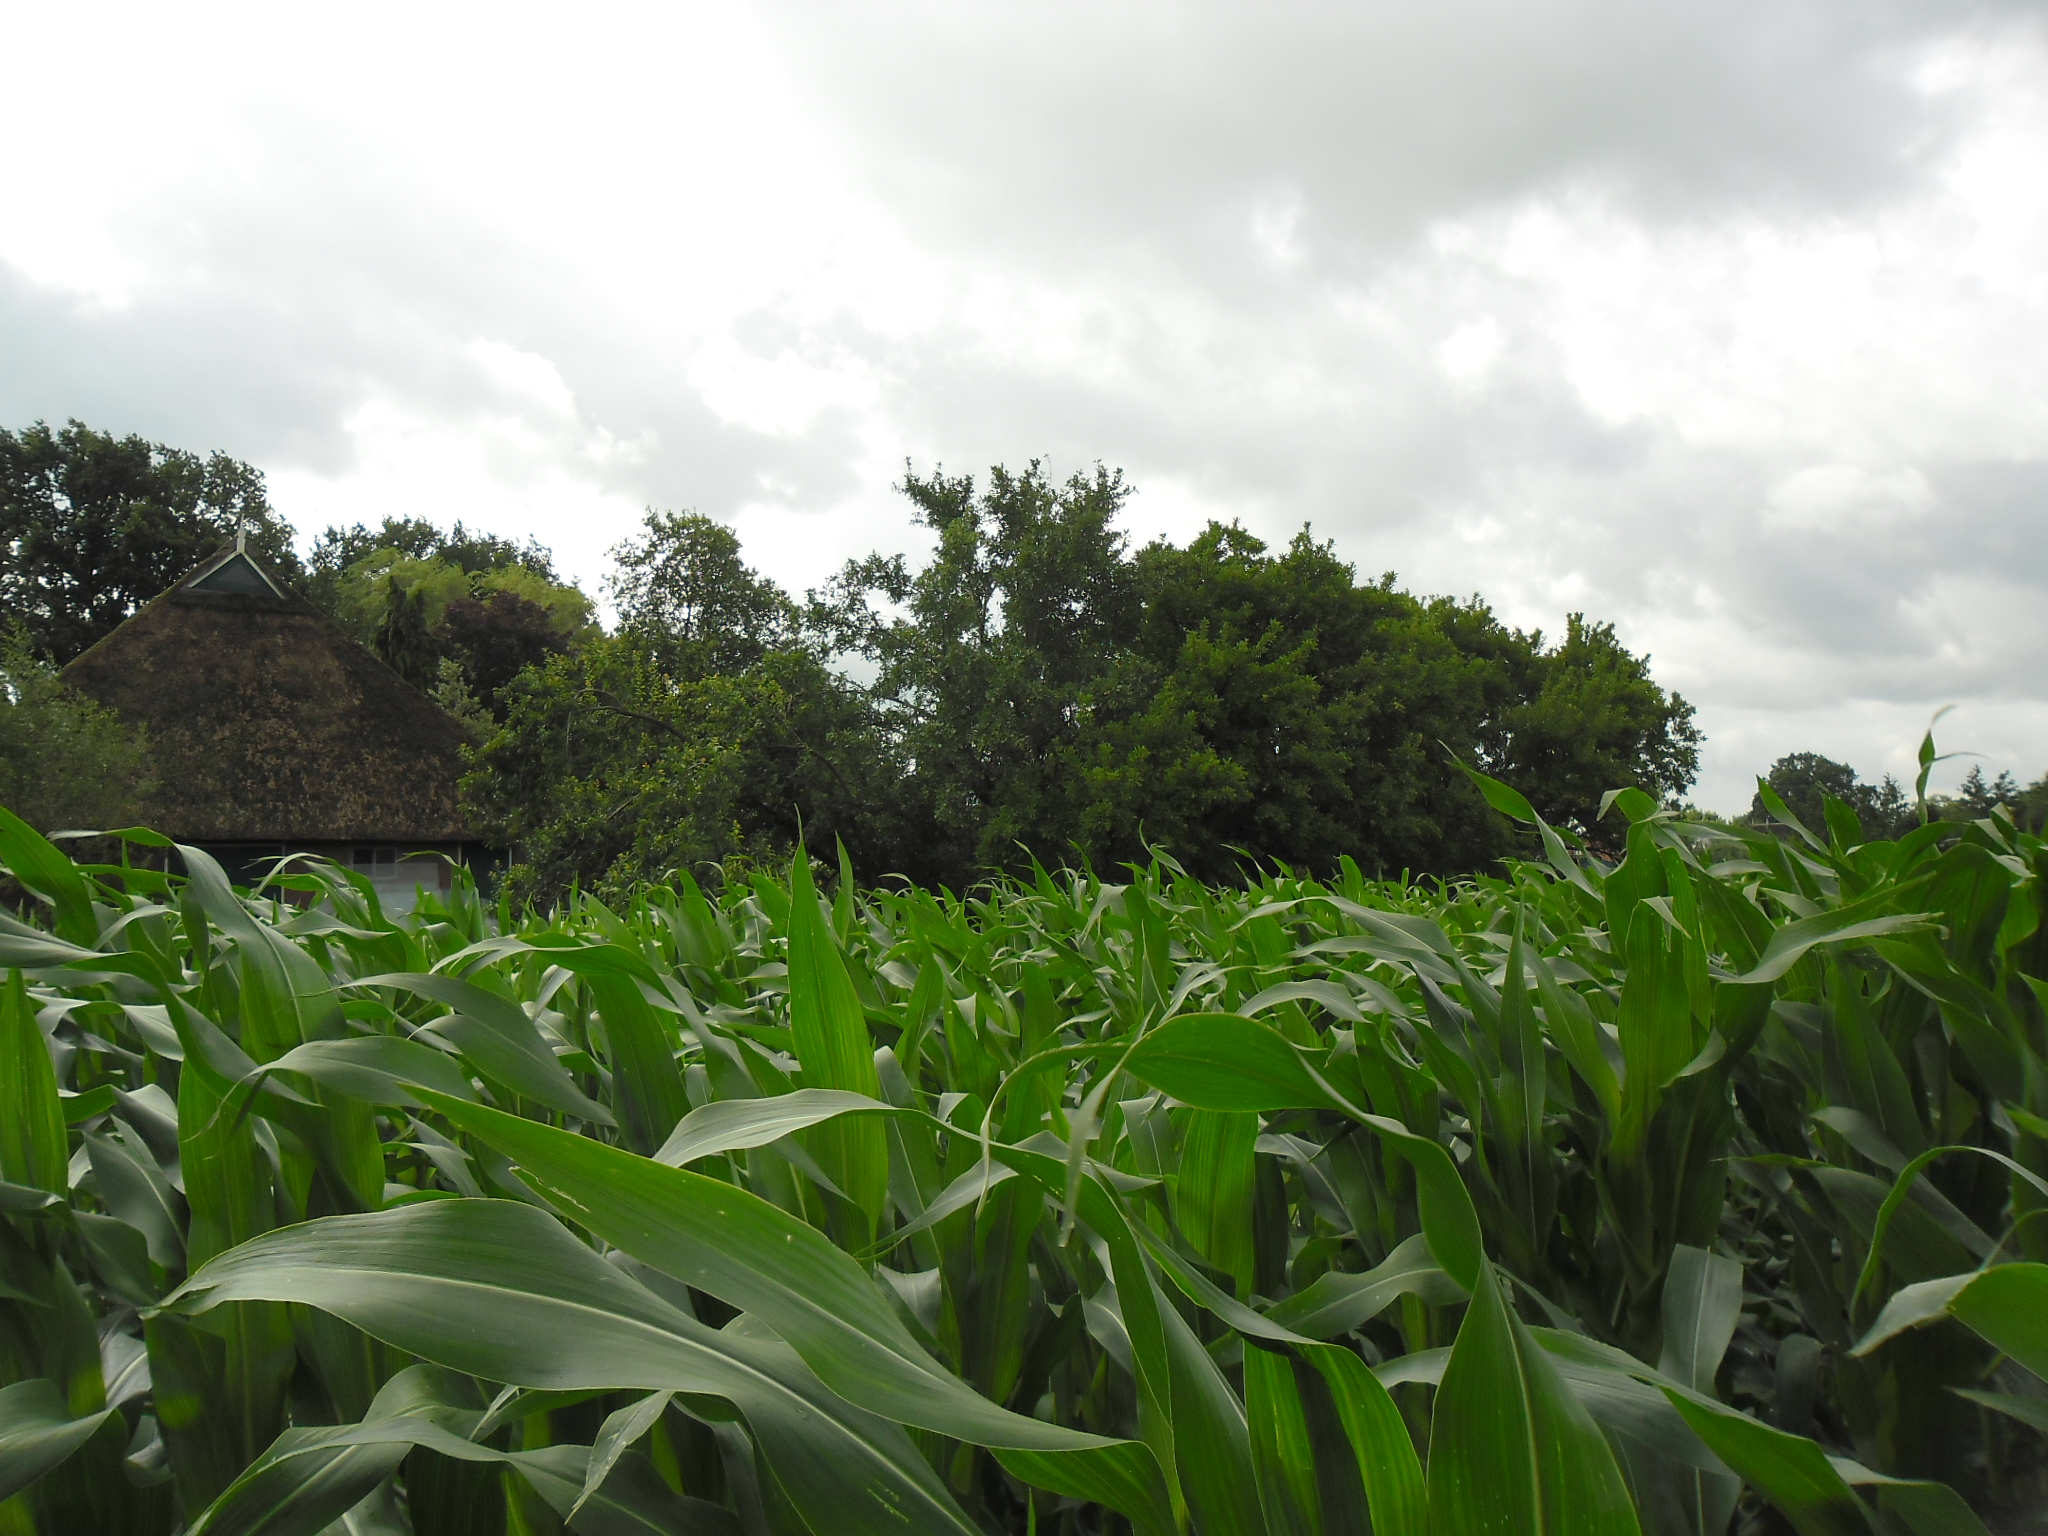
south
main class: Cropland
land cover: Maize
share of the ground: > 75 %
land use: Agriculture (excluding fallow land and kitchen gardens)
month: July
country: NL
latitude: 52.7294
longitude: 6.1642
